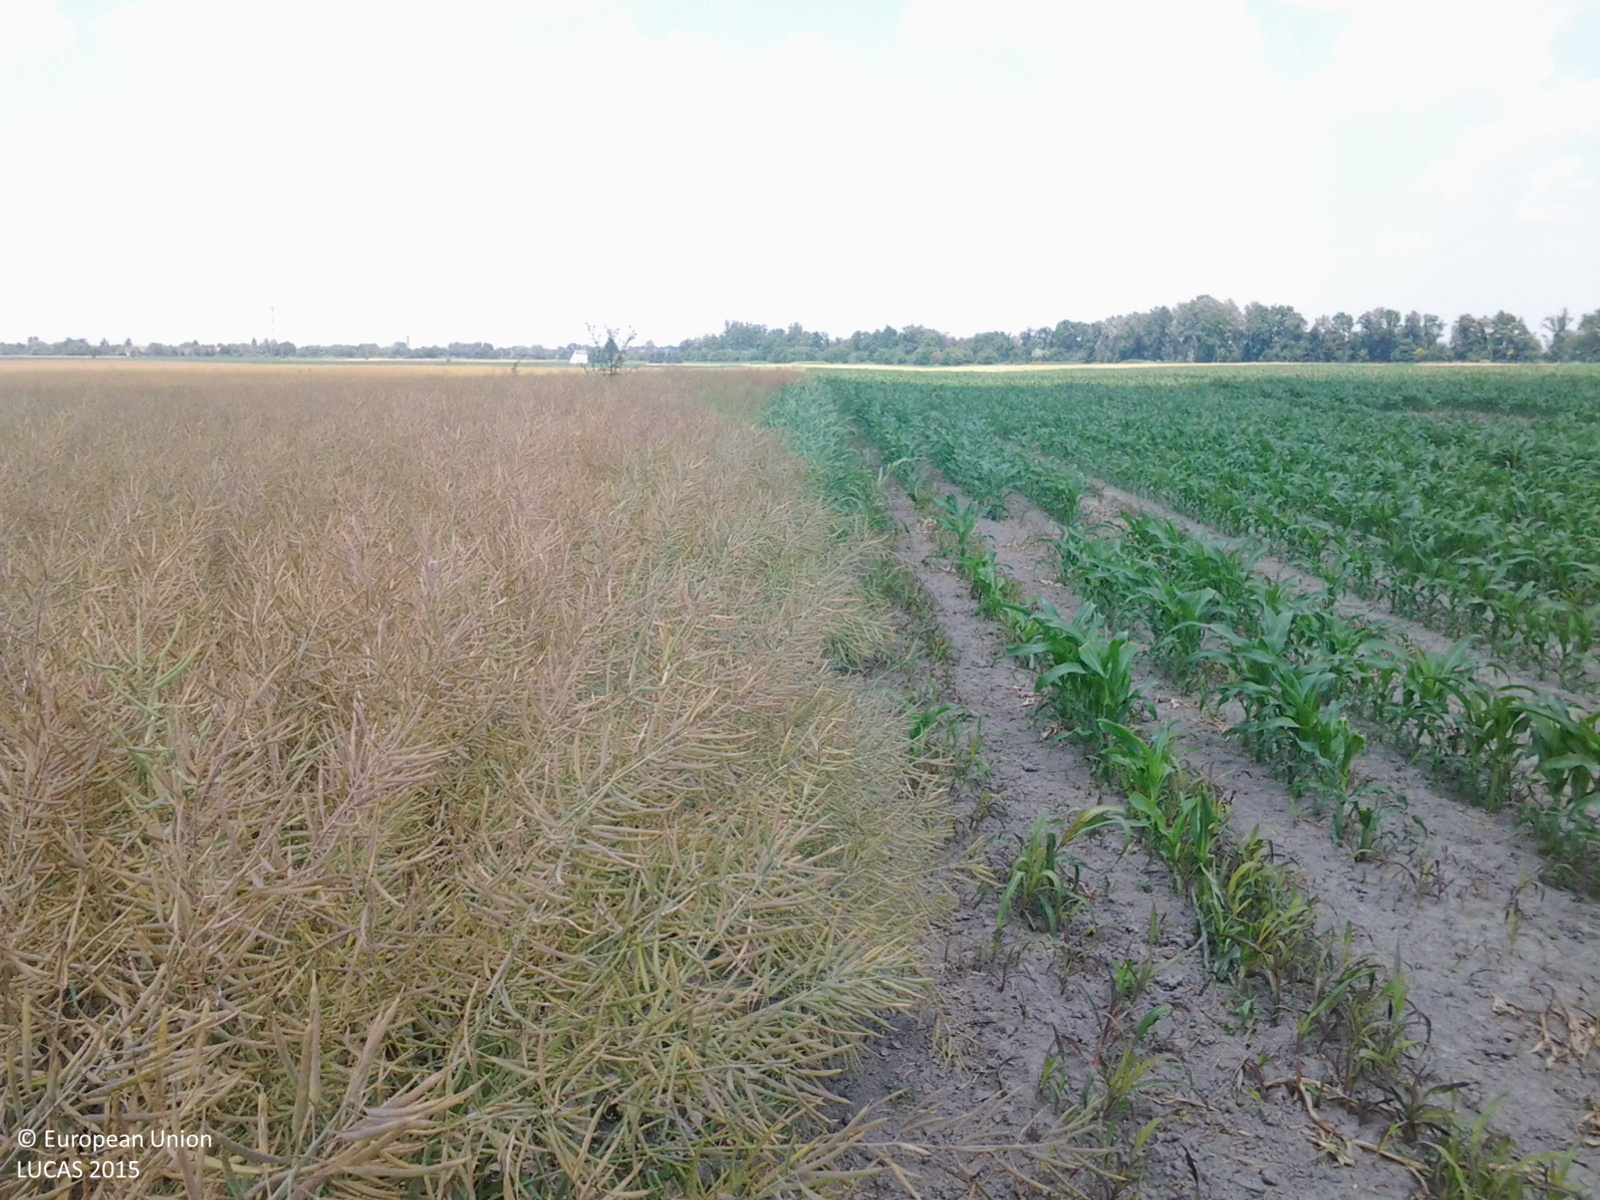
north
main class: Cropland
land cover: Rape and turnip rape
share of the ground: > 75 %
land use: Agriculture (excluding fallow land and kitchen gardens)
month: June
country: HU
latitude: 46.6223
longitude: 19.0122
